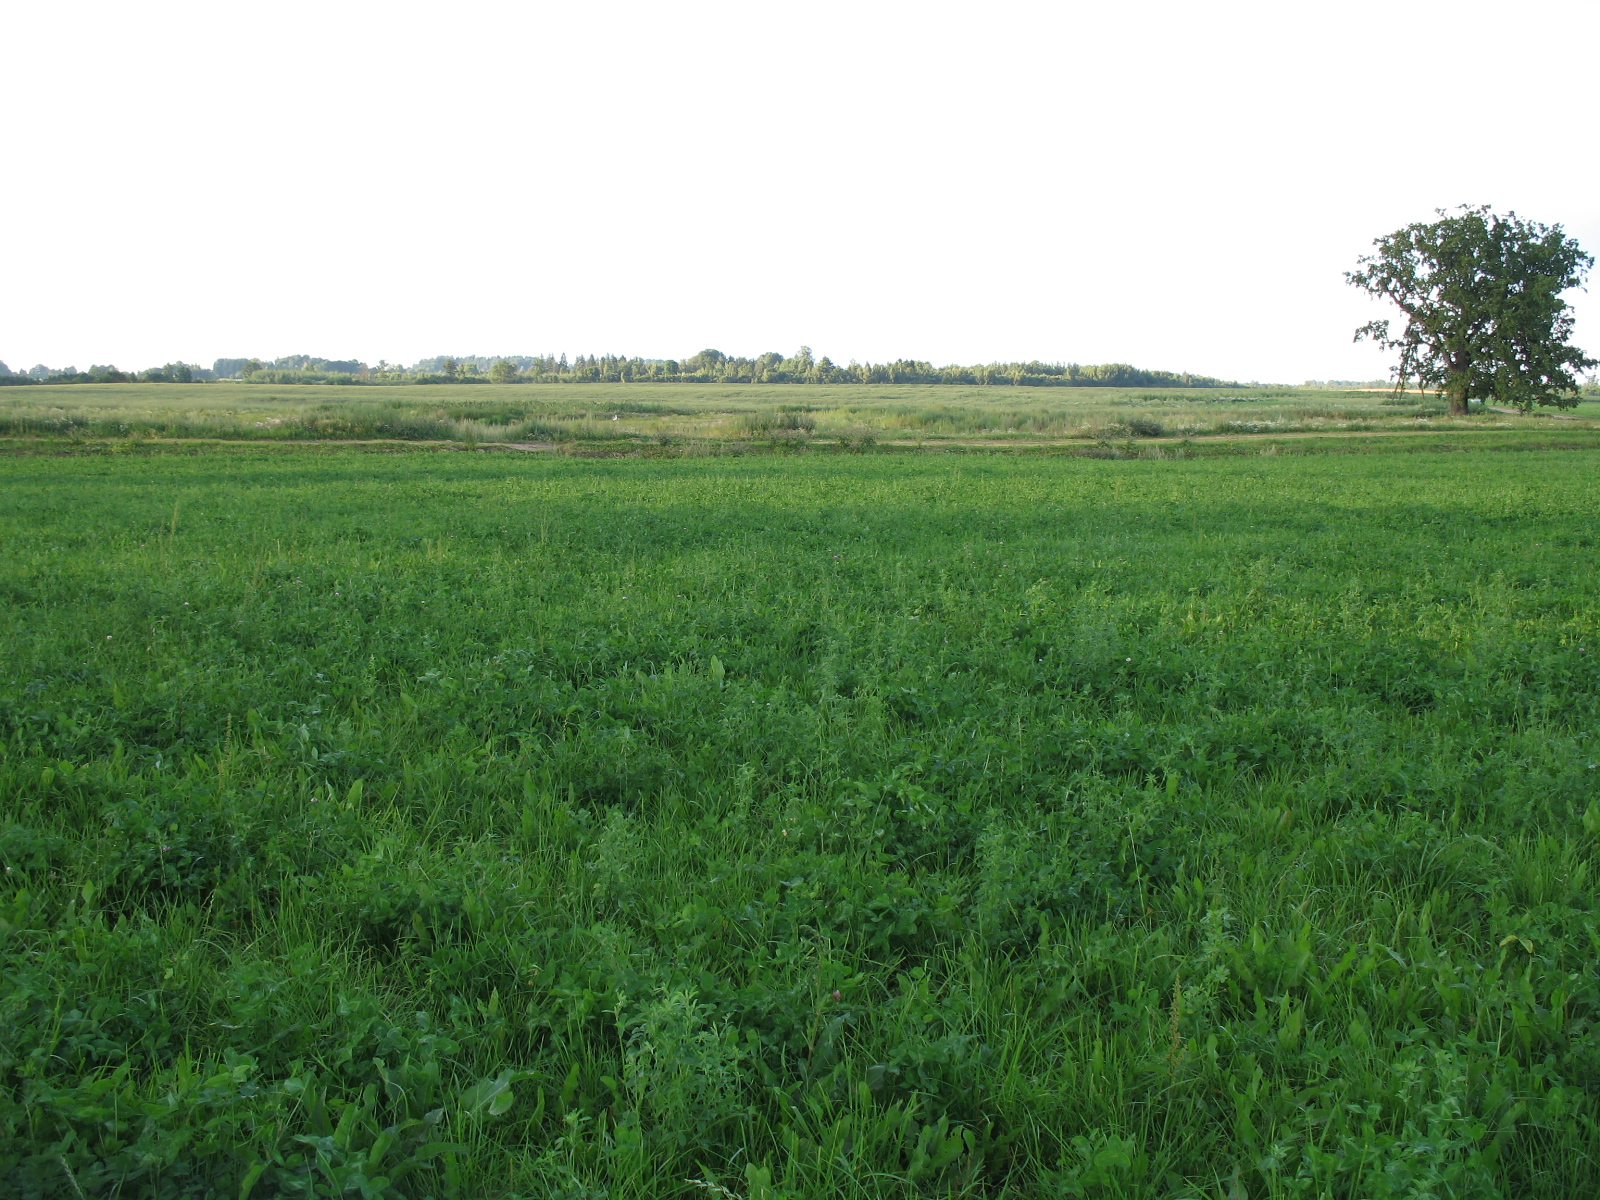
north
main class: Grassland
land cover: Grassland without tree/shrub cover
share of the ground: > 75 %
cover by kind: herbaceous plants 100 %
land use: Agriculture (excluding fallow land and kitchen gardens)
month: August
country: LV
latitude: 56.2894
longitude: 25.4518
